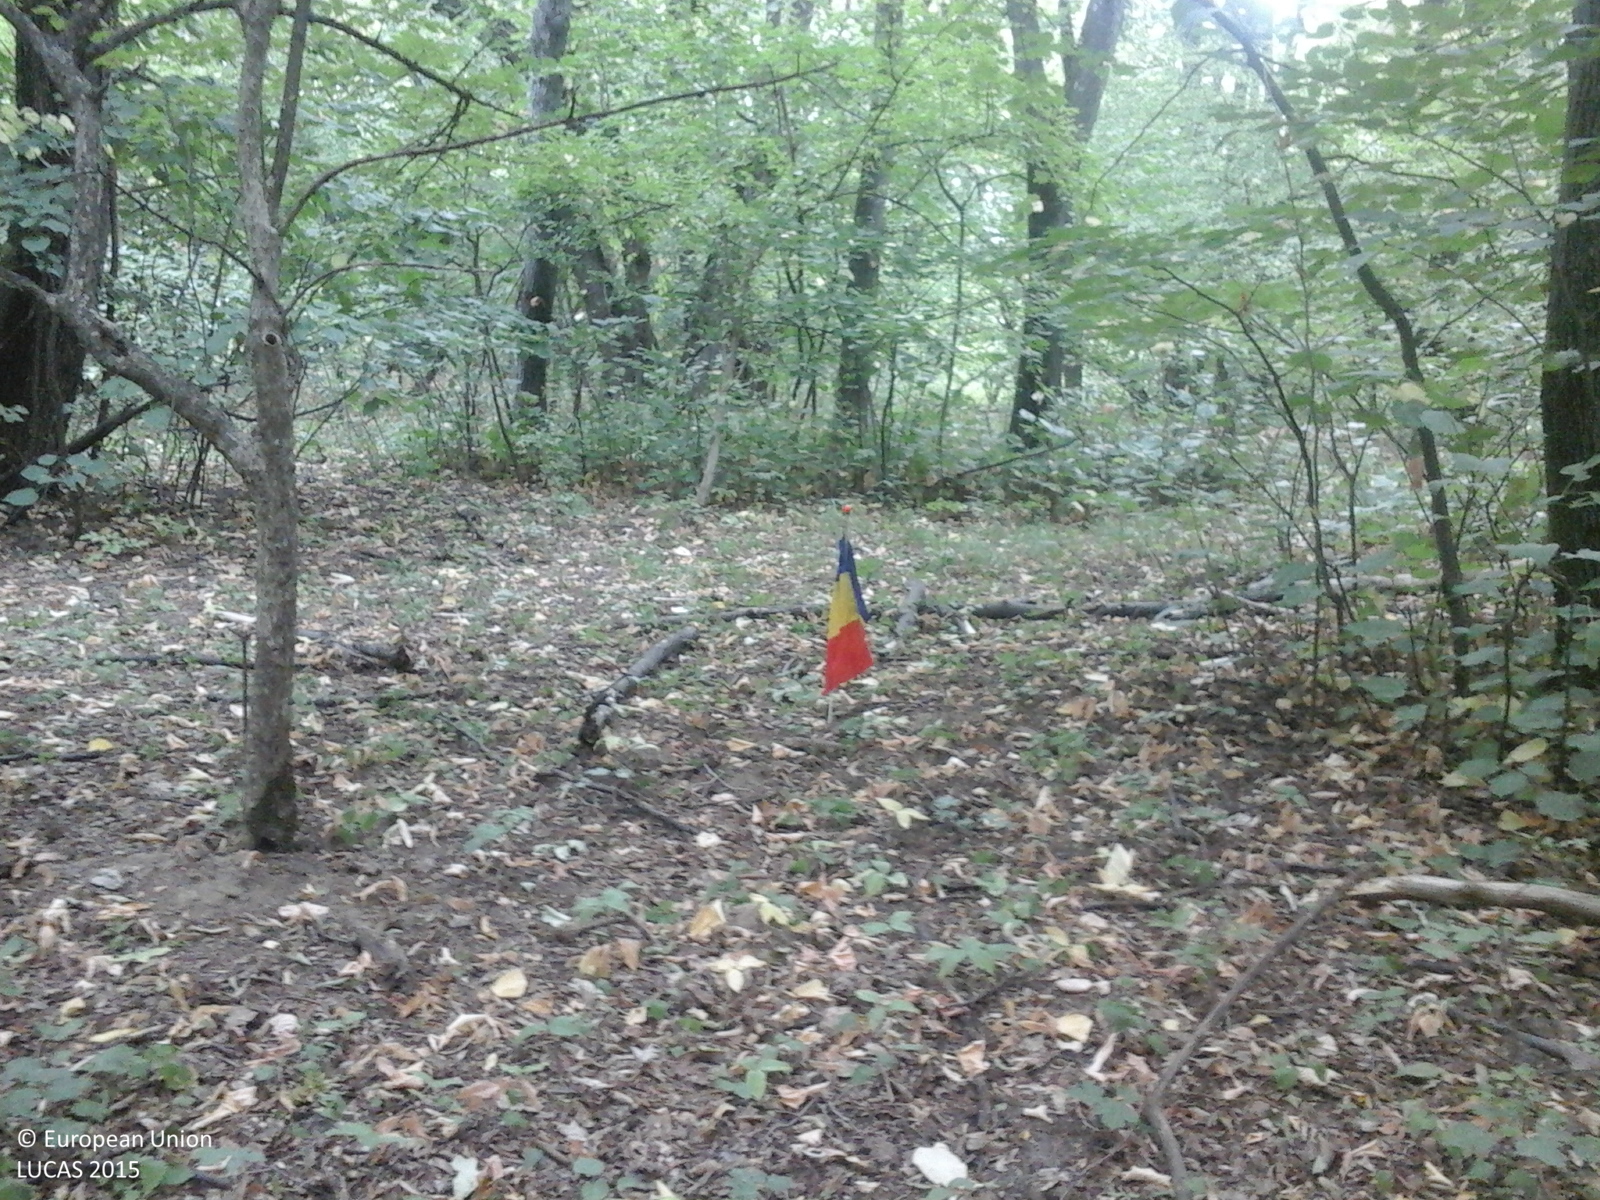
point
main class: Woodland
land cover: Broadleaved woodland
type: mesophytic deciduous forest
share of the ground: > 75 %
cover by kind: broadleaved forest trees 100 %
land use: Forestry
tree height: > 5 m
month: July
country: RO
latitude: 45.2559
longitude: 28.3881
